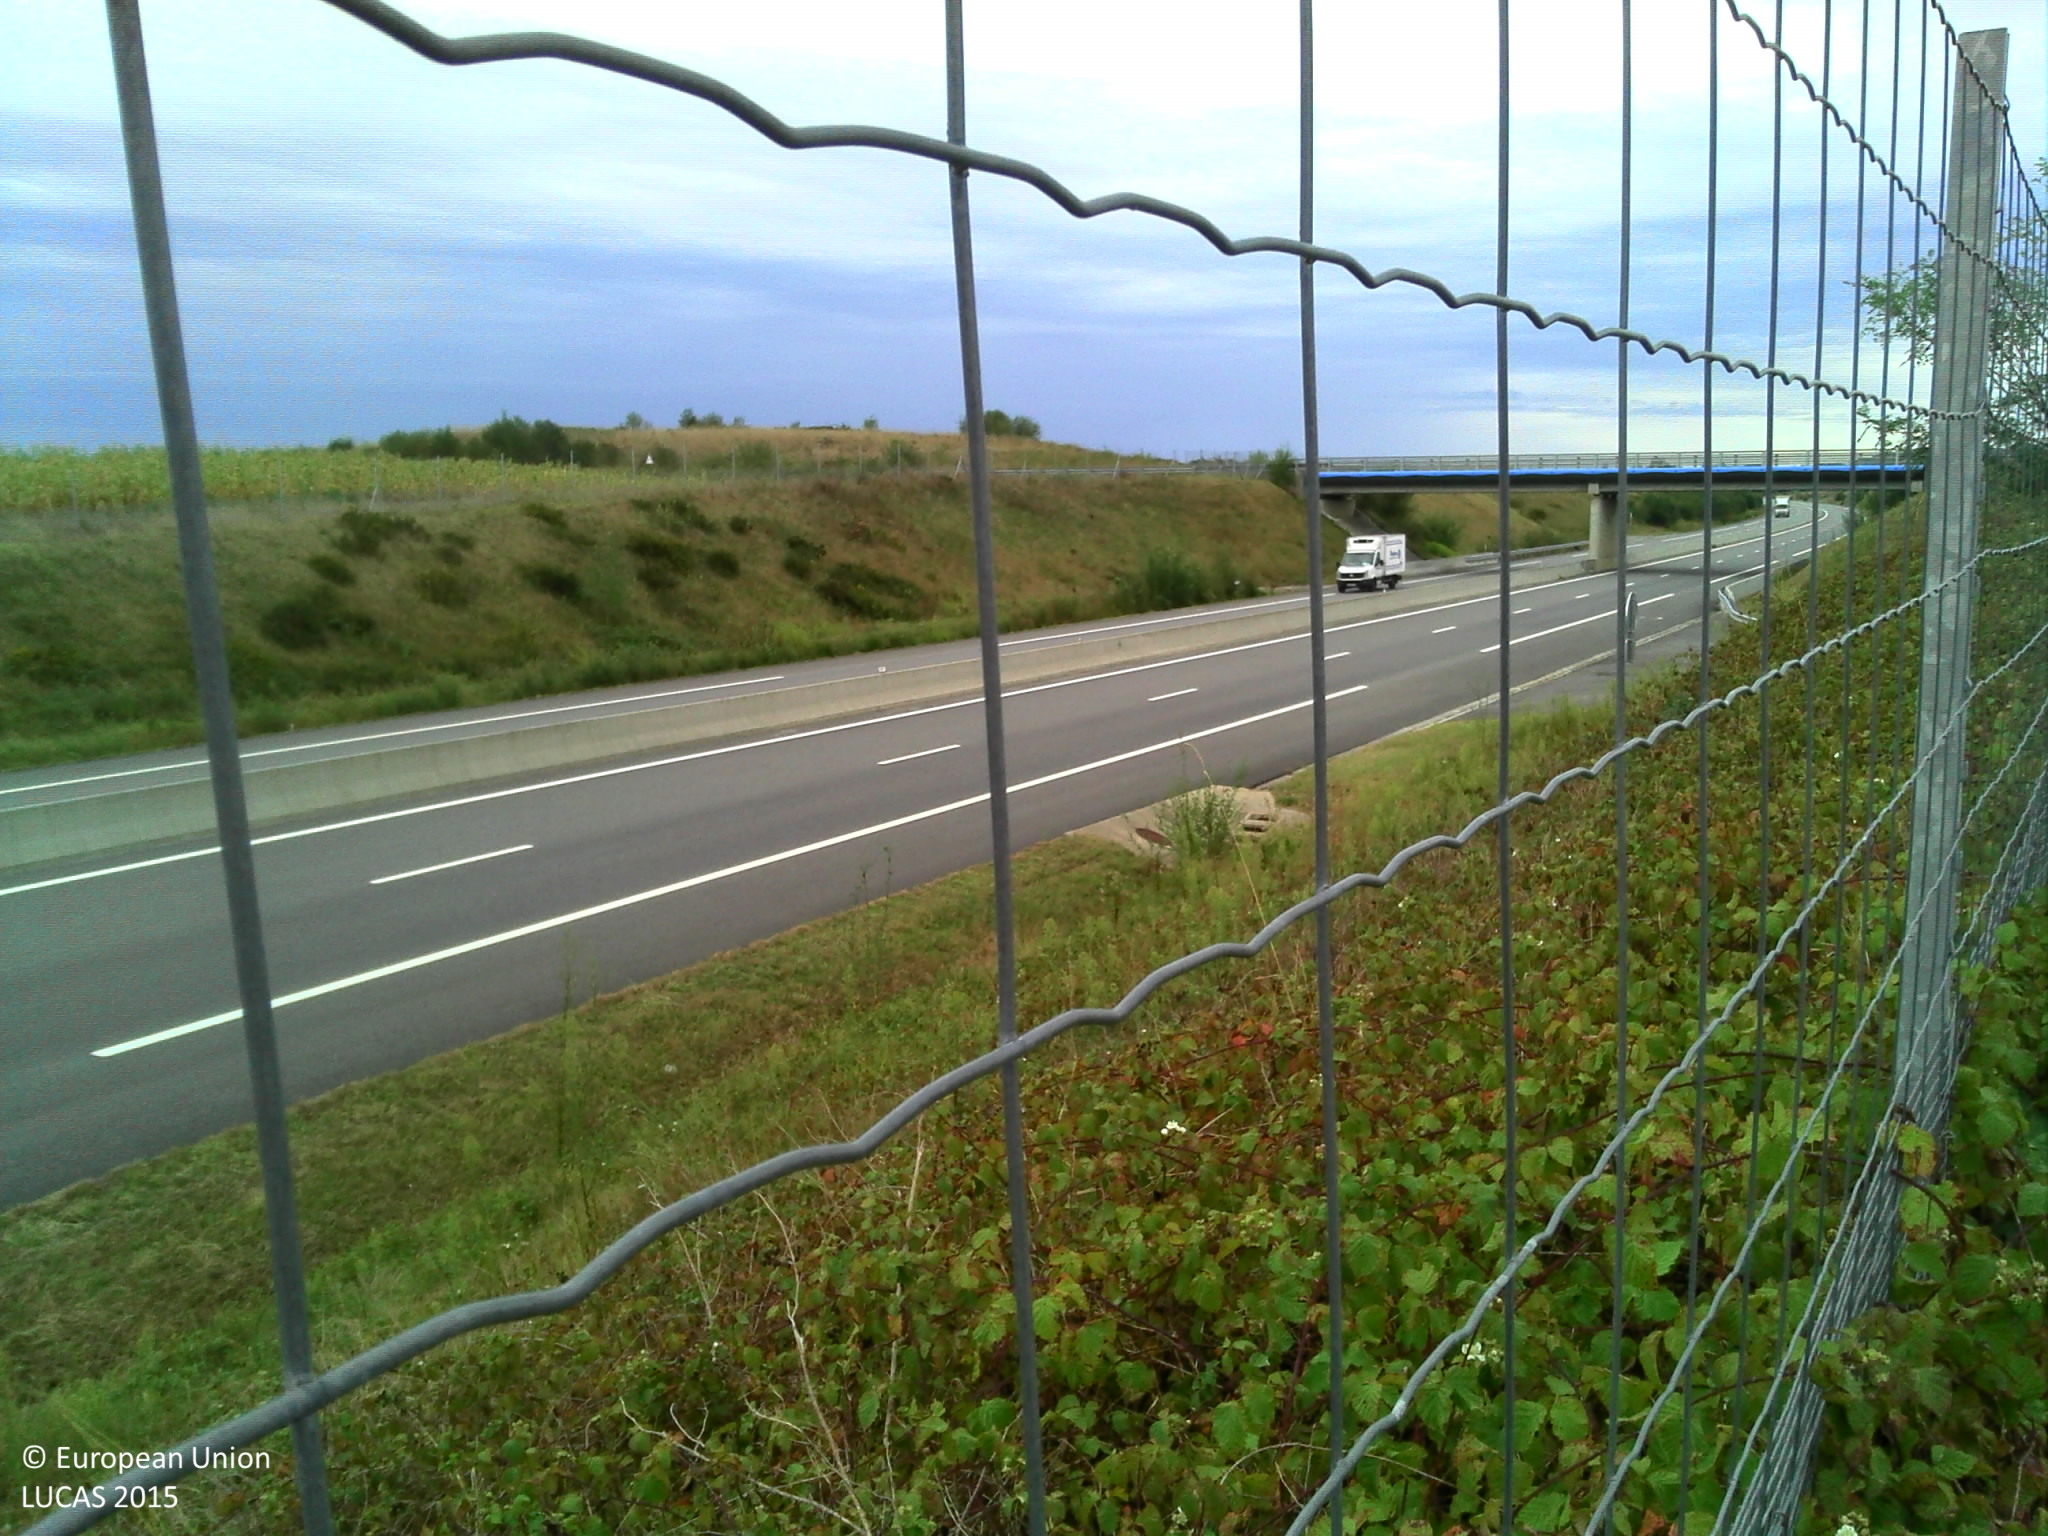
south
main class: Grassland
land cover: Grassland without tree/shrub cover
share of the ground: > 75 %
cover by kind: herbaceous plants 95 %, shrubs 5 %
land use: Road transport
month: September
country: FR
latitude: 43.4221
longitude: -0.4453
